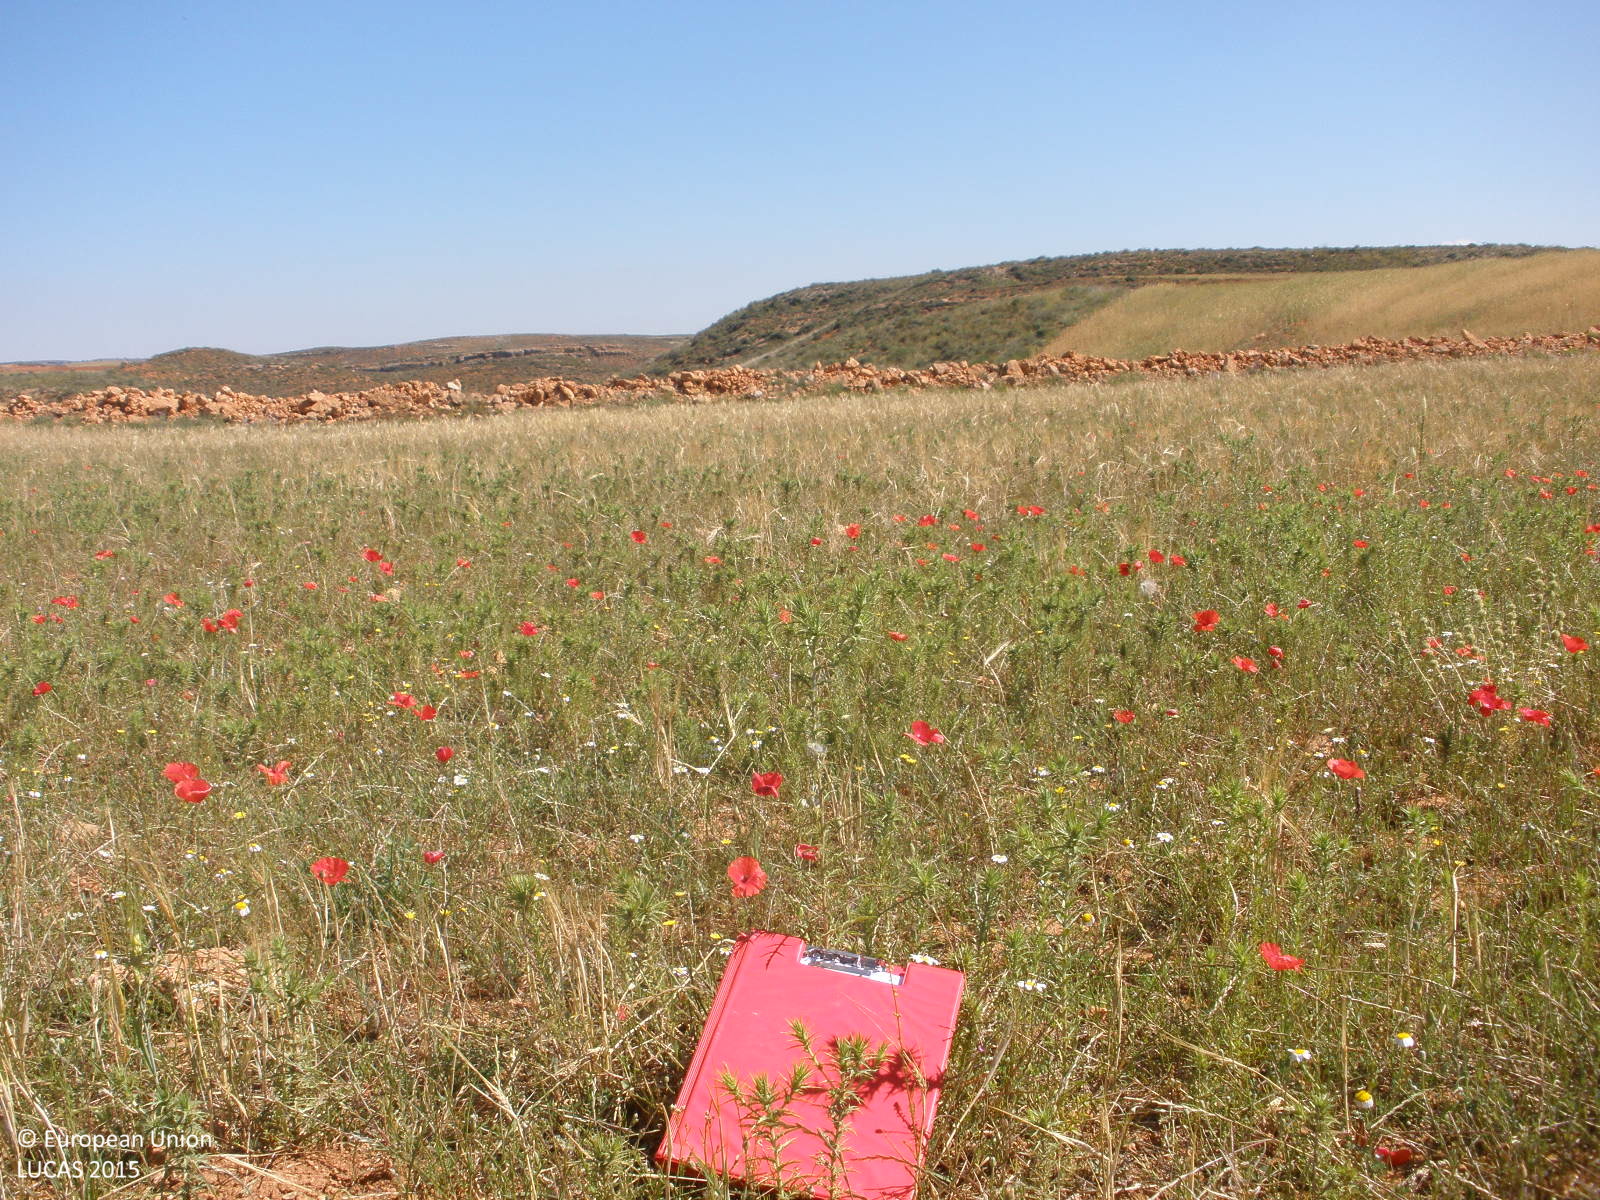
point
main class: Grassland
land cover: Spontaneously vegetated surfaces
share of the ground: > 75 %
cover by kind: herbaceous plants 90 %, unconsolidated bare surface 10 %
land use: Fallow land
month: June
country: ES
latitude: 40.5323
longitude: -1.0740
